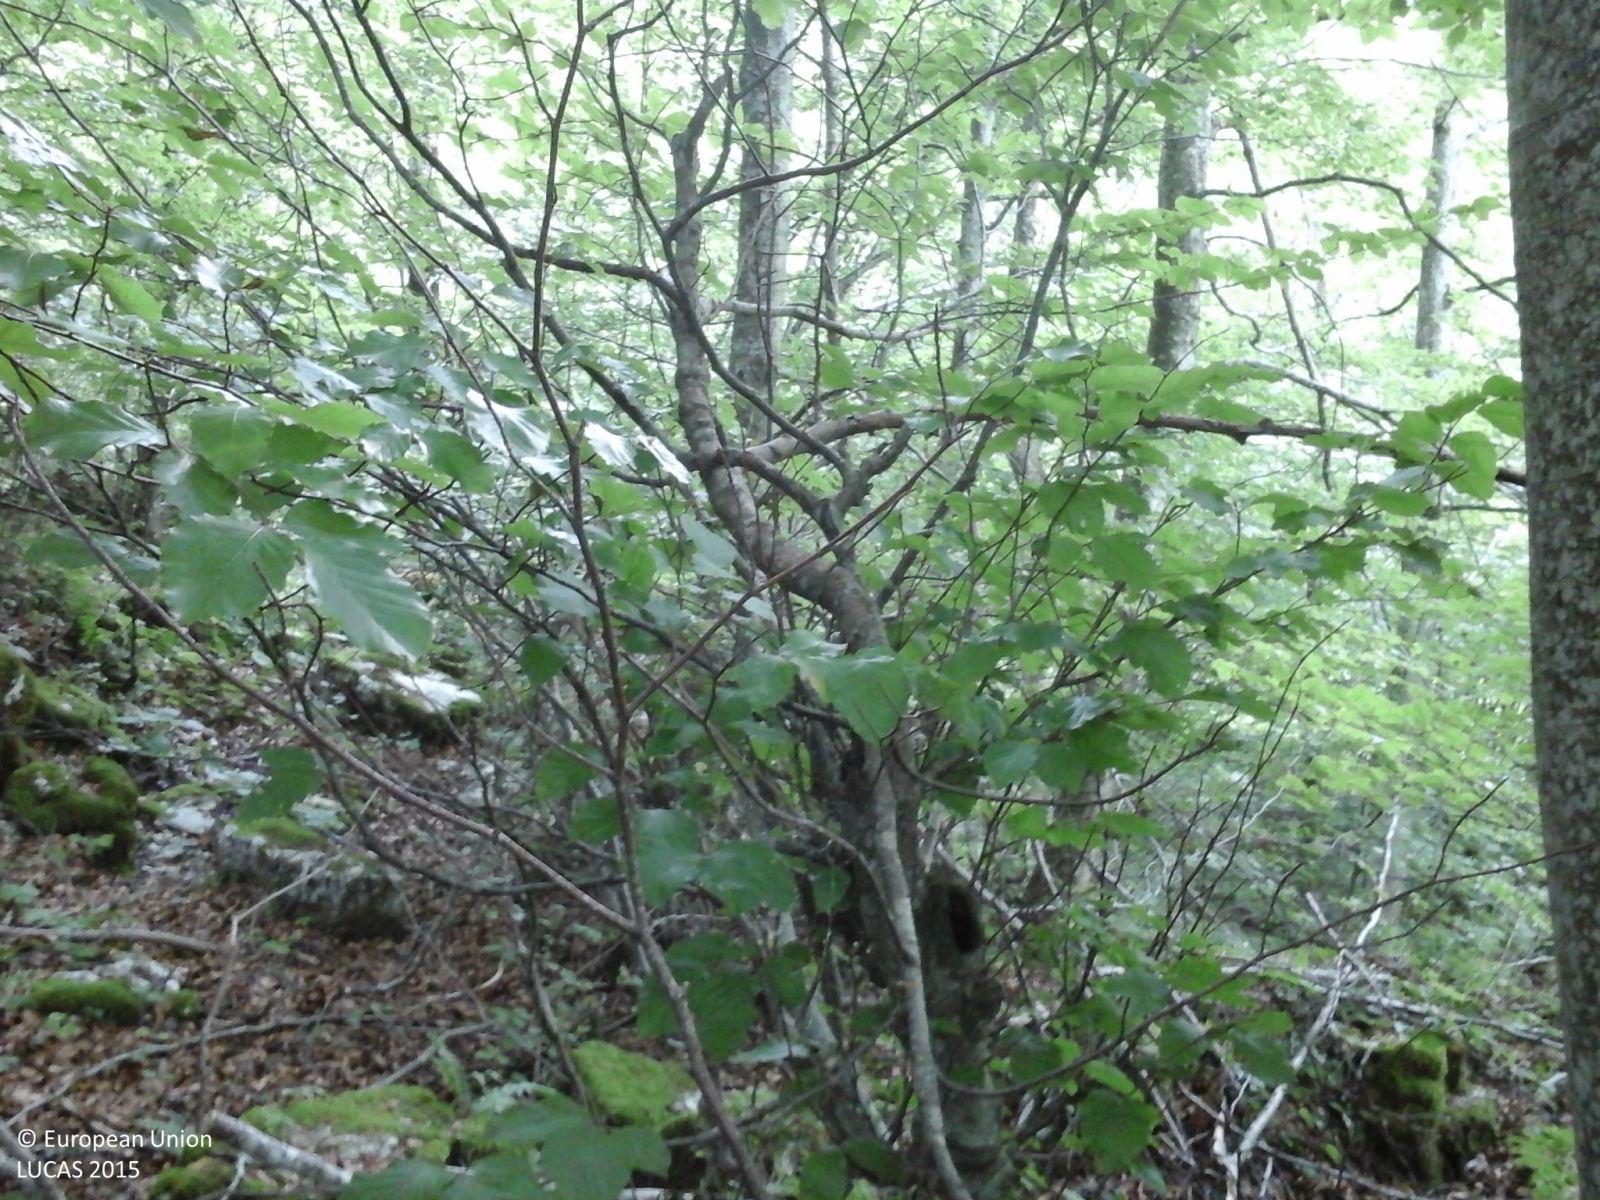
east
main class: Woodland
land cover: Broadleaved woodland
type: mountainous beech forest
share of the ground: > 75 %
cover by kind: broadleaved forest trees 100 %
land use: Forestry
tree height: > 5 m
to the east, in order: Broadleaved woodland
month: June
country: IT
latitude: 45.8522
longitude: 11.6331
